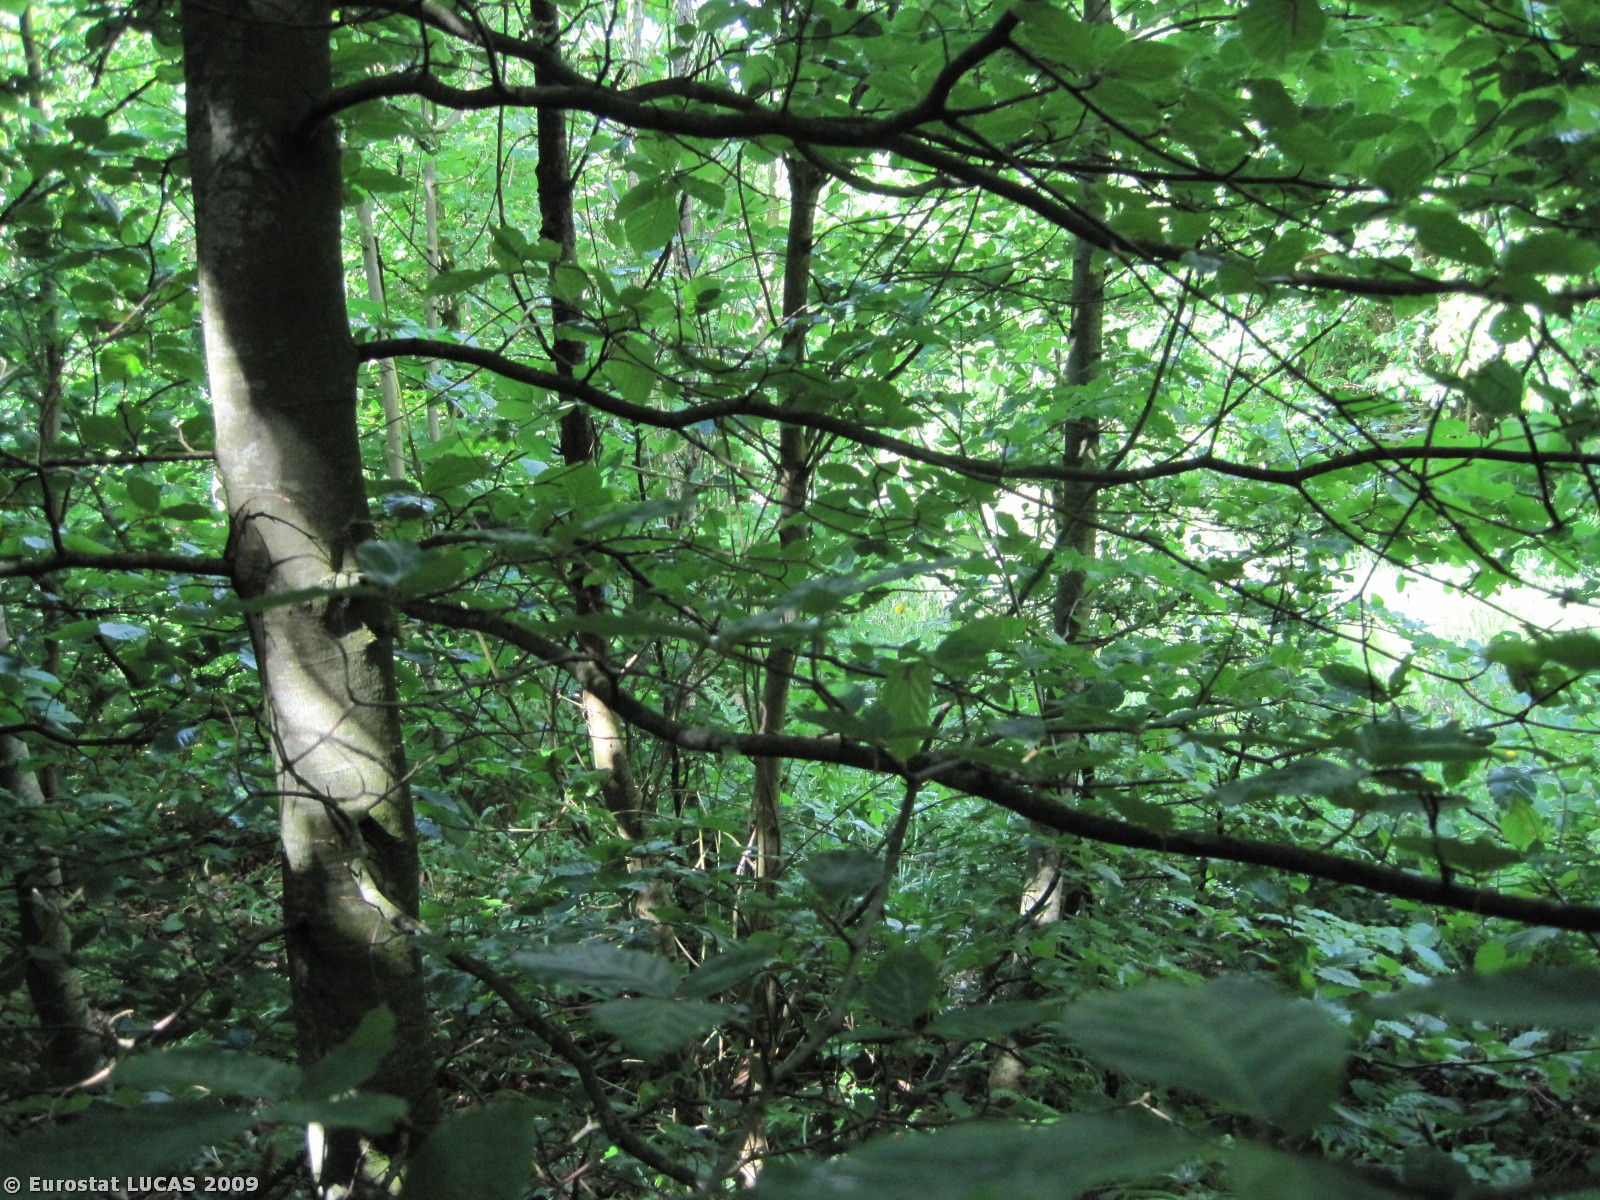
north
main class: Woodland
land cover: Broadleaved woodland
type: beech forest
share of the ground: > 75 %
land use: Forestry
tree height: > 5 m
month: May
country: DK
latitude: 56.5830
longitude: 9.7886
